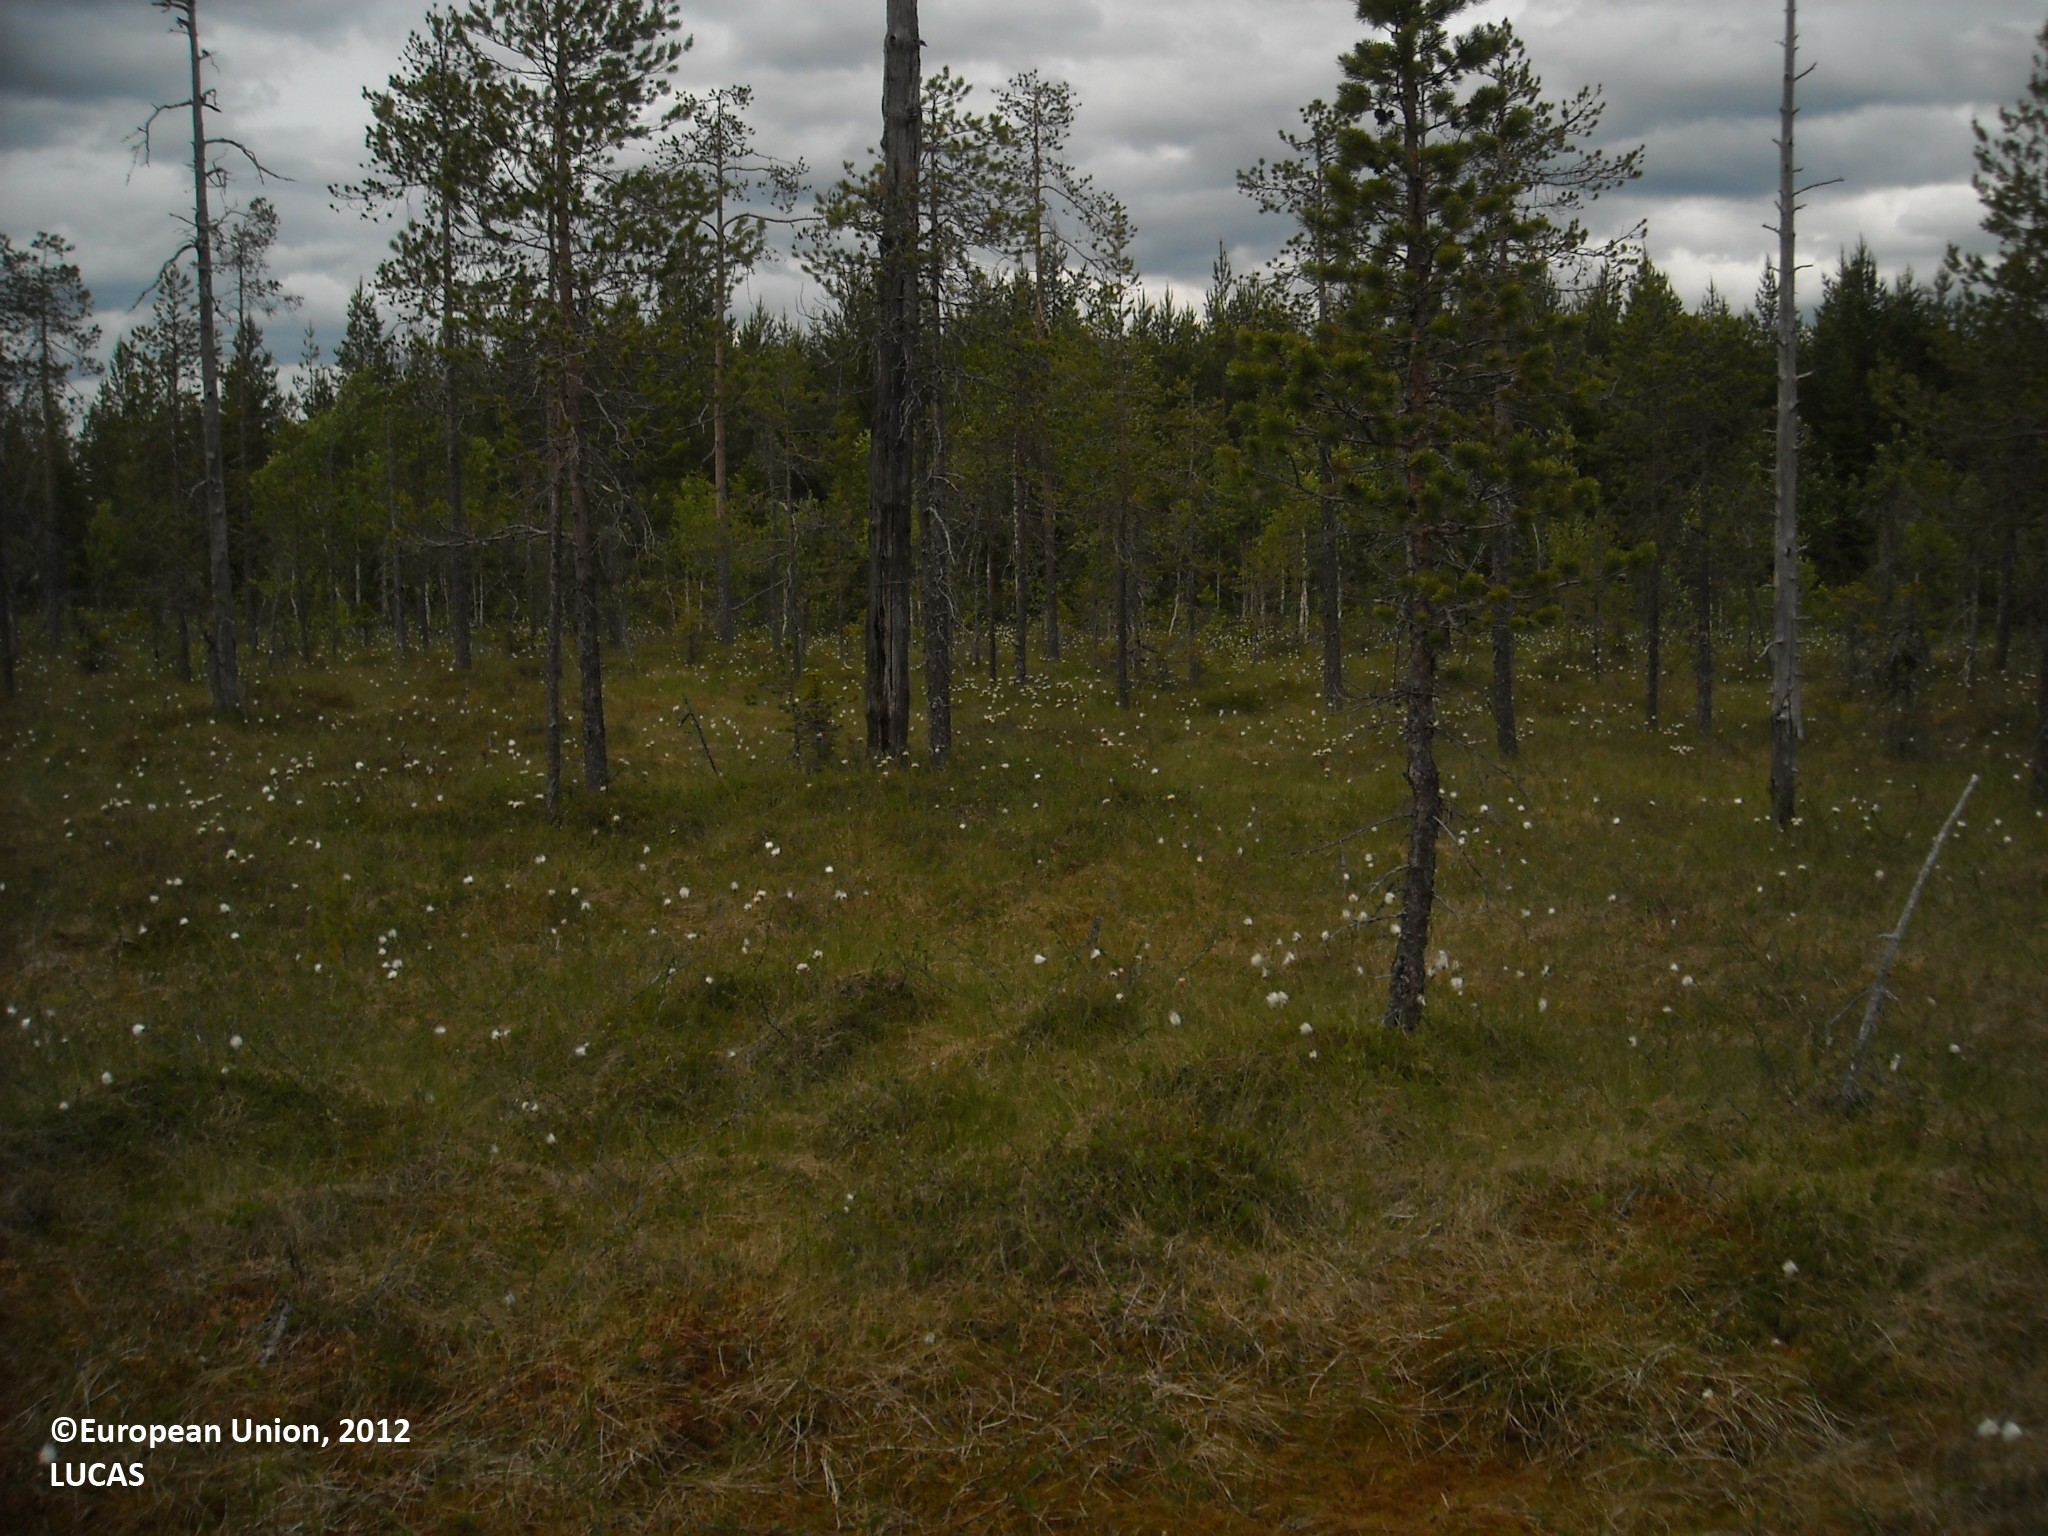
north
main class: Woodland
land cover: Pine dominated coniferous woodland
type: mire and swamp forests
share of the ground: 10 - 25 %
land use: Semi-natural and natural areas not in use
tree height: > 5 m
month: June
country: FI
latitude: 64.8843
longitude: 27.9961
